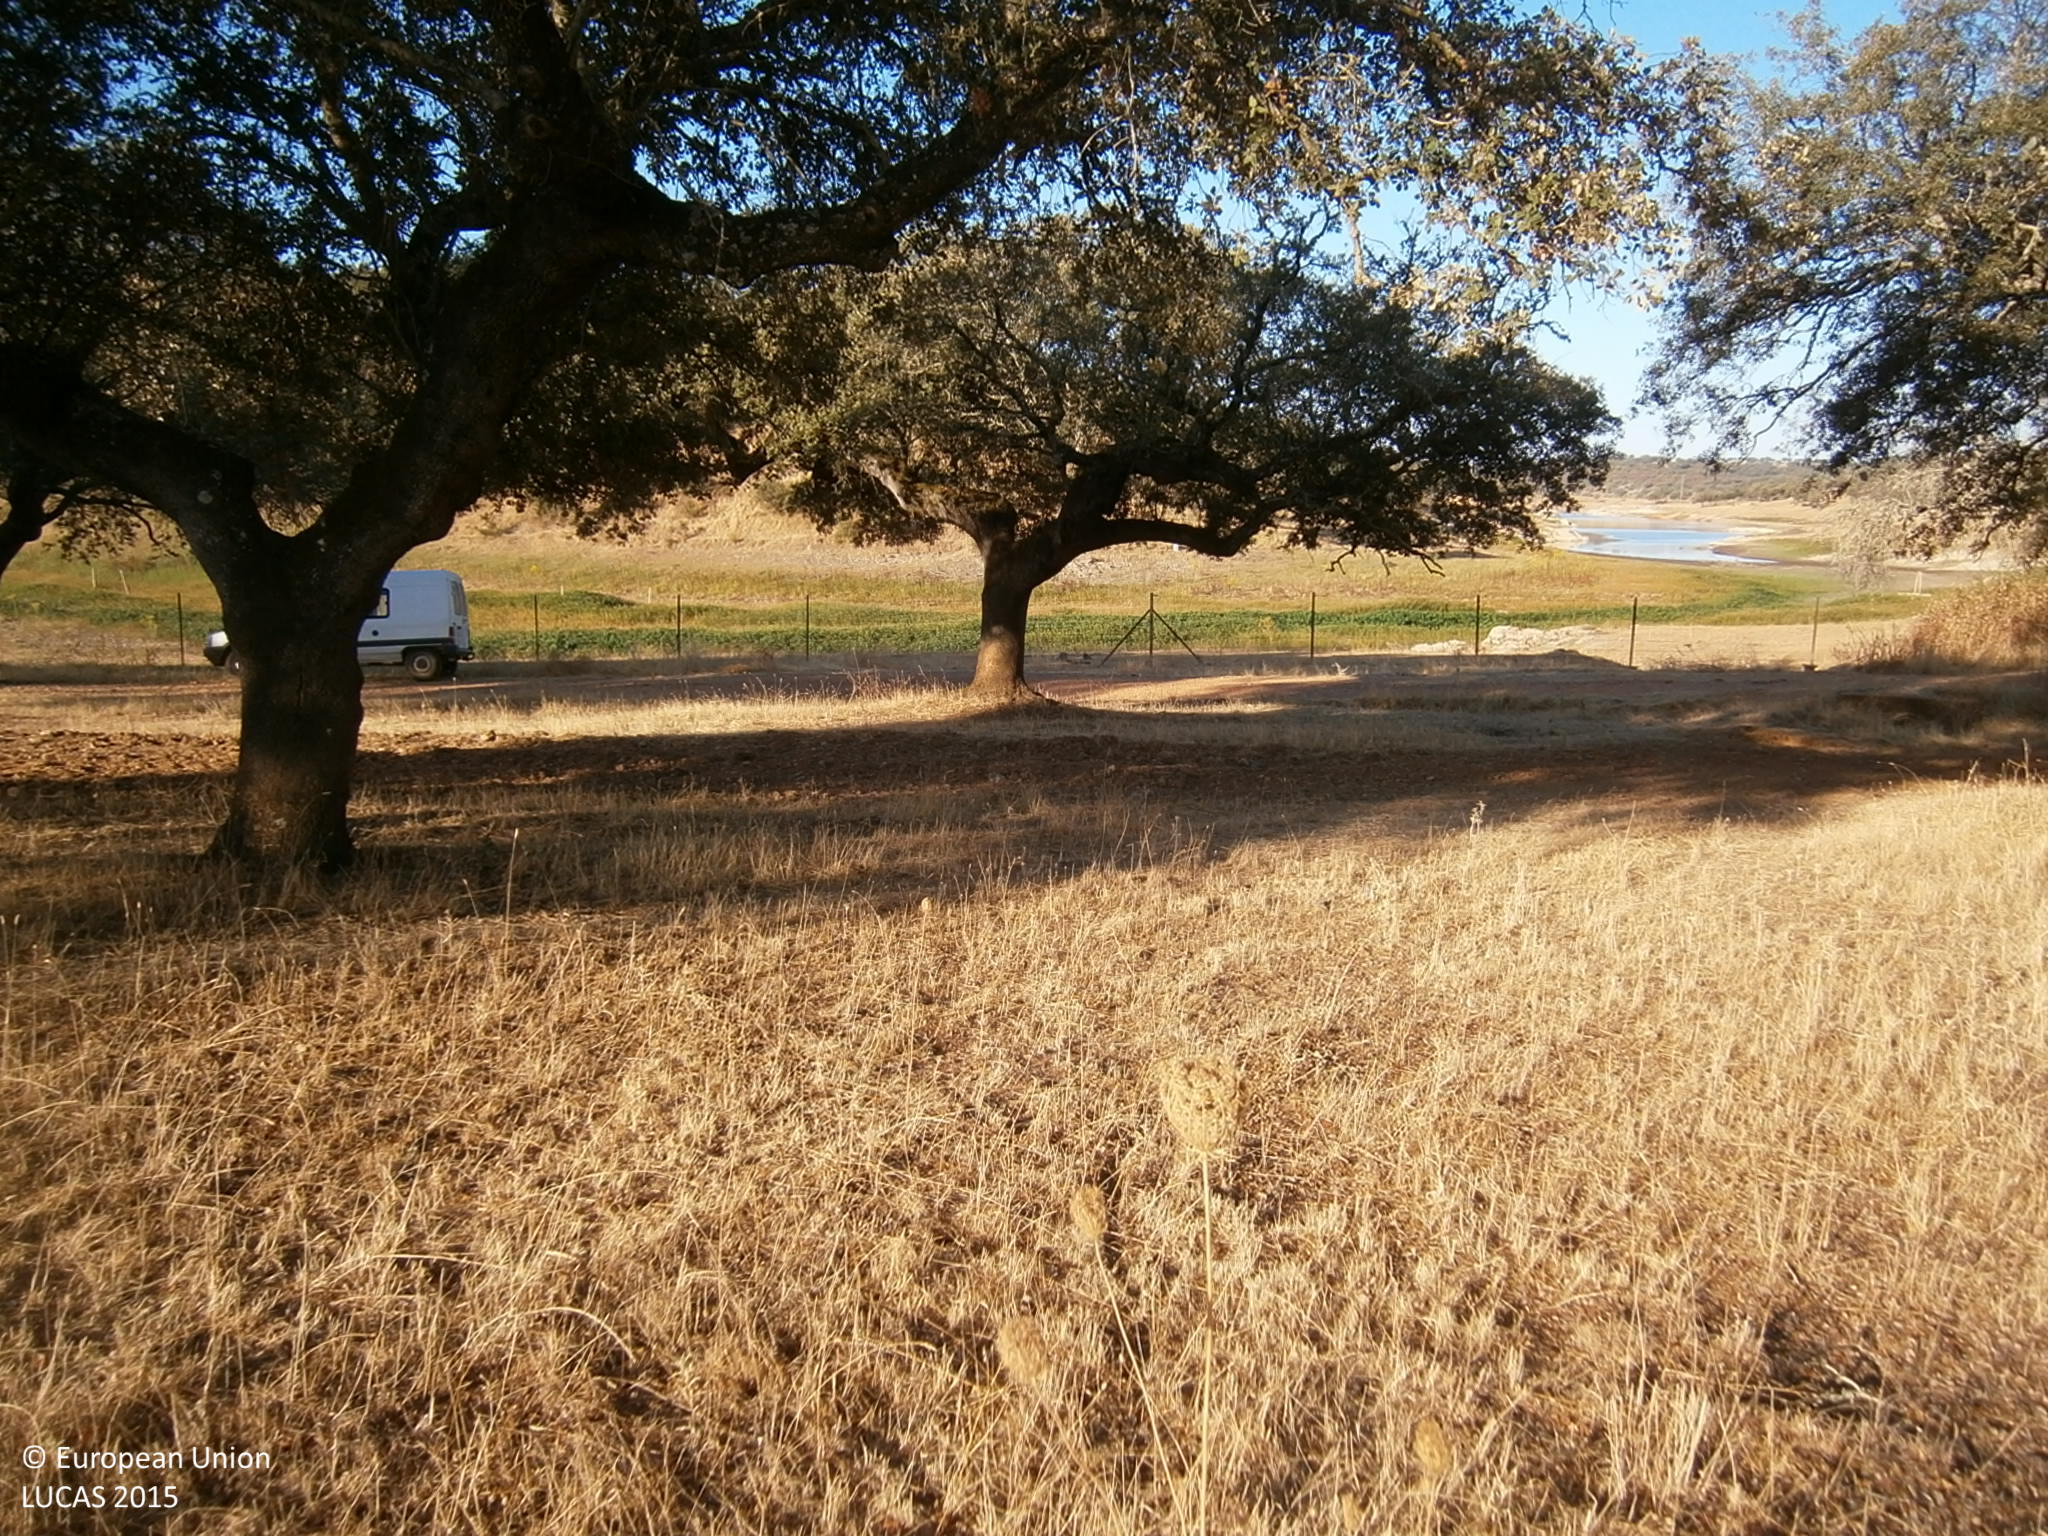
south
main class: Woodland
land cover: Broadleaved woodland
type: broadleaved evergreen forest
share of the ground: 50 - 75 %
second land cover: Spontaneously vegetated surfaces
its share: > 75 %
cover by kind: broadleaved forest trees 65 %, herbaceous plants 35 %
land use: Forestry
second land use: Agriculture (excluding fallow land and kitchen gardens)
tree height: > 5 m
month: July
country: ES
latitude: 38.6701
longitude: -7.2549
